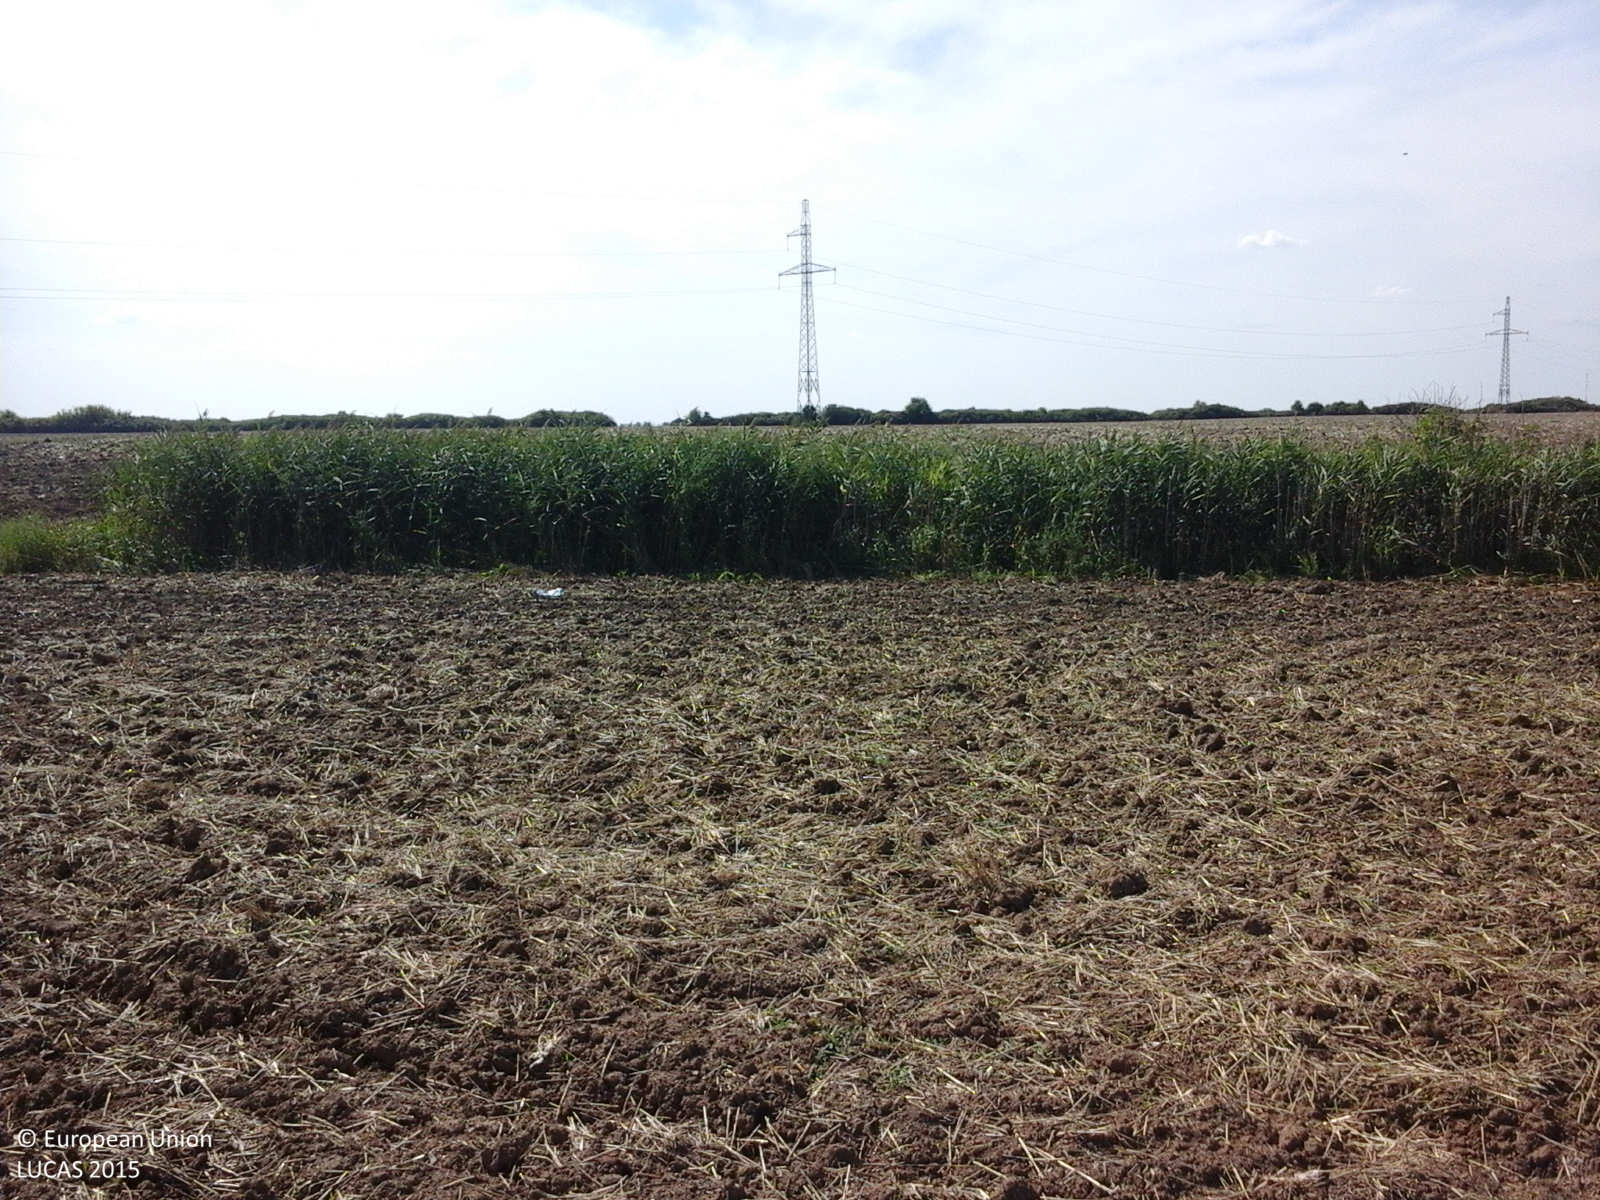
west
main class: Cropland
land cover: Common wheat
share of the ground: 25 - 50 %
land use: Agriculture (excluding fallow land and kitchen gardens)
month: August
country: RO
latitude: 45.7332
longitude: 21.1195
